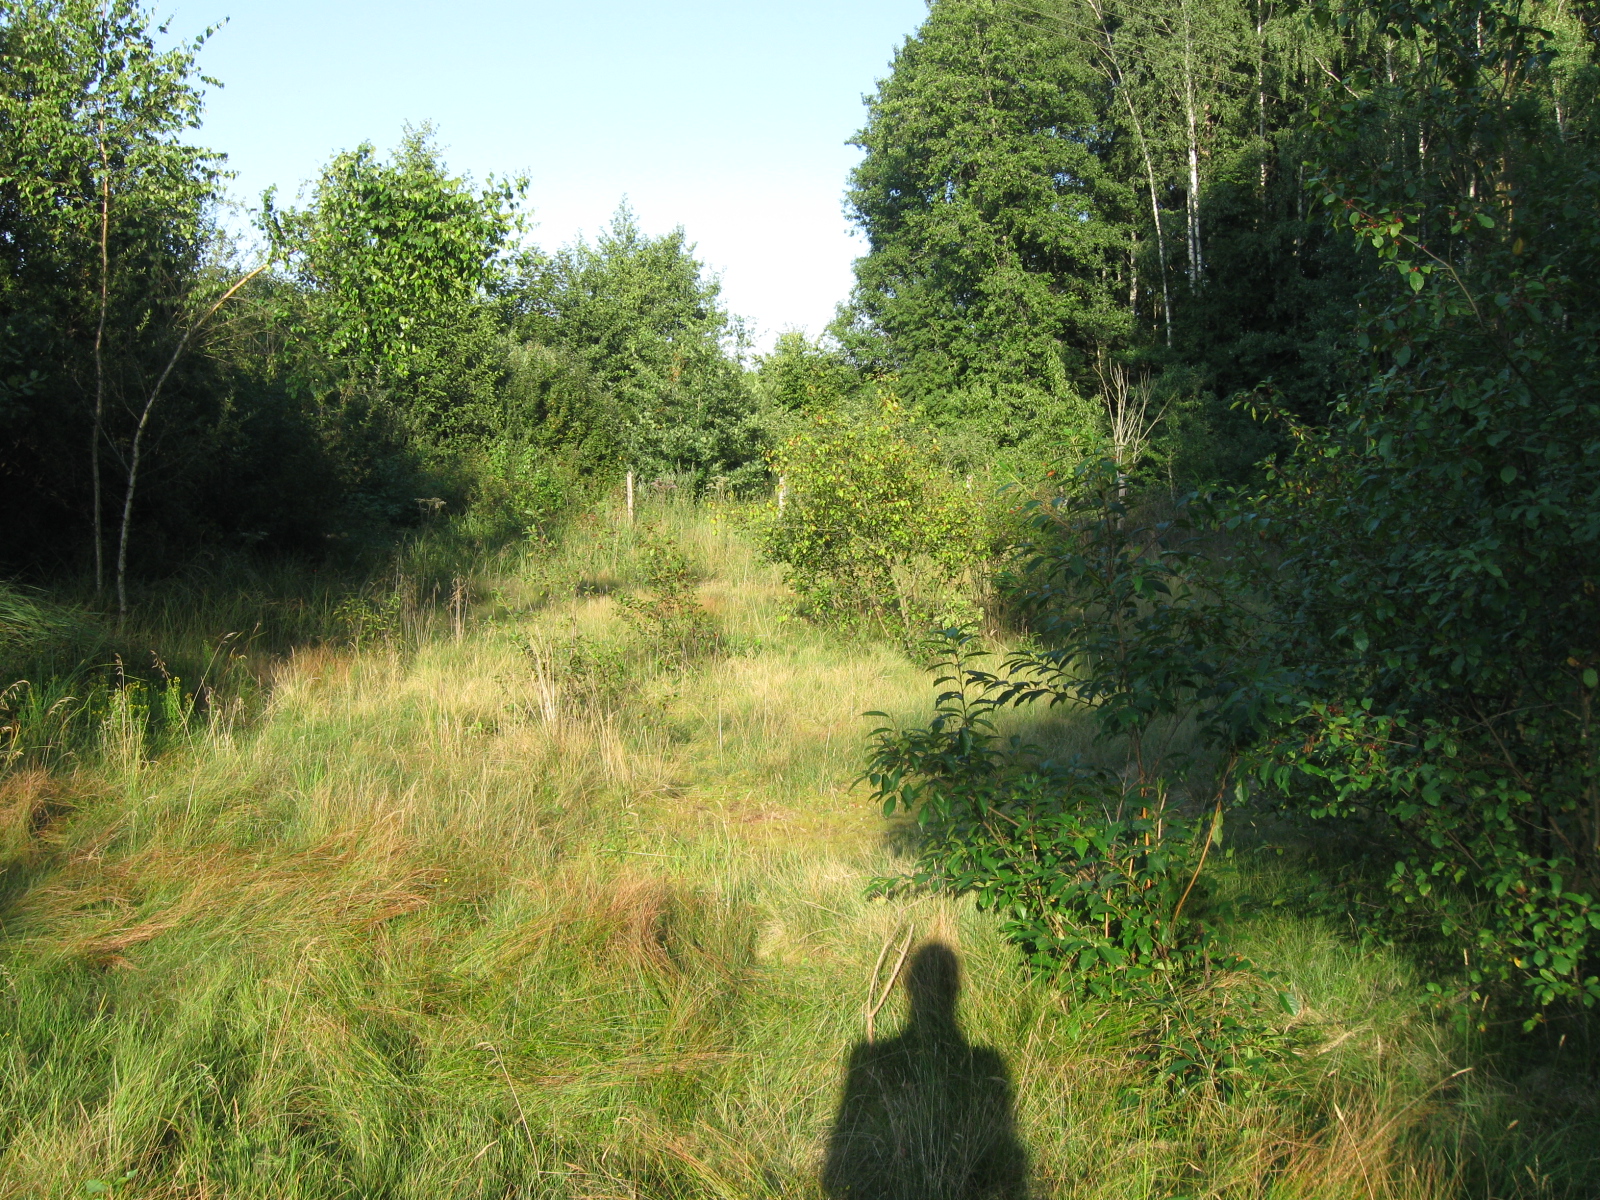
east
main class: Grassland
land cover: Grassland with sparse tree/shrub cover
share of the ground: > 75 %
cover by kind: herbaceous plants 75 %, lichens and mosses 15 %, broadleaved forest trees 5 %, shrubs 5 %
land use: Semi-natural and natural areas not in use
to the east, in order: Grassland with sparse tree/shrub cover; Electric lines; Fences; Apple fruit; Broadleaved woodland; Tracks; Spontaneously vegetated surfaces; Abandoned hedges; Ditches and canals; Abandoned hedges; Grassland without tree/shrub cover
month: August
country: LT
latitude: 54.8184
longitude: 23.4485
